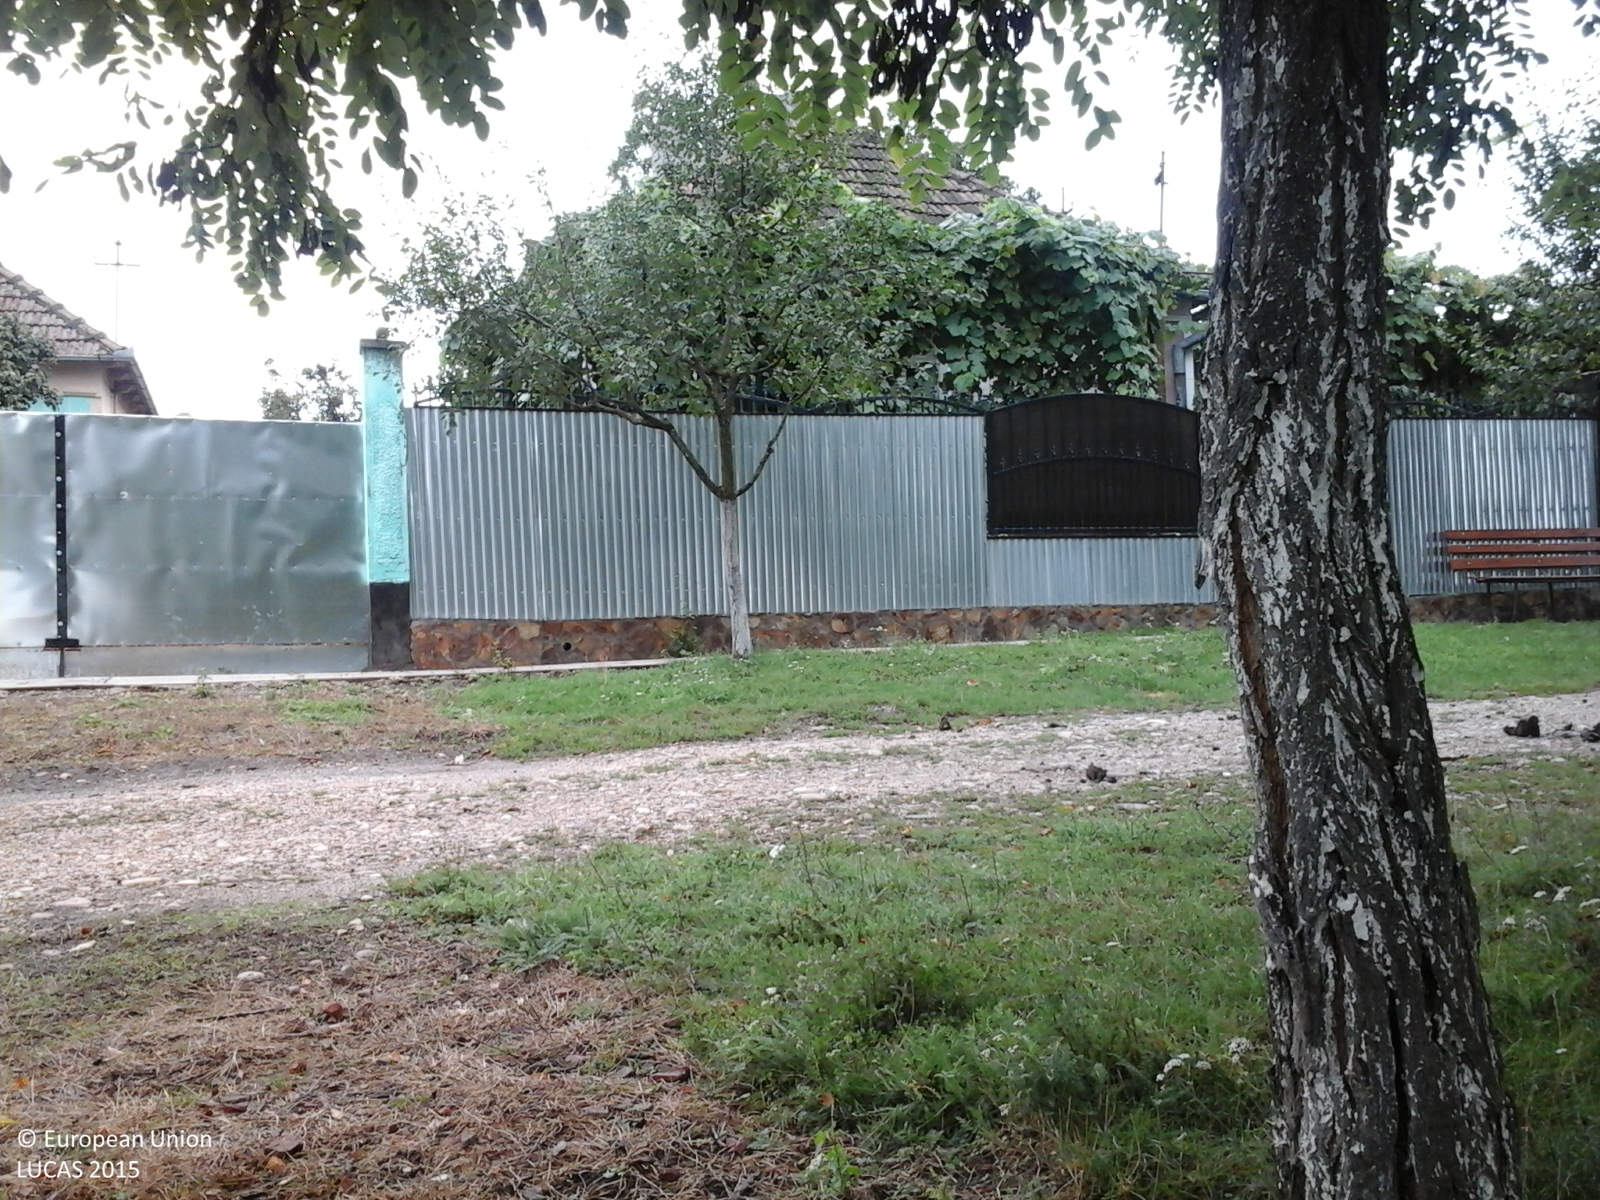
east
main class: Woodland
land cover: Broadleaved woodland
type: exotic forest
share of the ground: > 75 %
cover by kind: broadleaved forest trees 100 %
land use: Forestry
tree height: > 5 m
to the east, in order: Broadleaved woodland; Artificial constructions in urban areas; Maize; Artificial constructions in urban areas
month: September
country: RO
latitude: 46.8411
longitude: 21.8053
